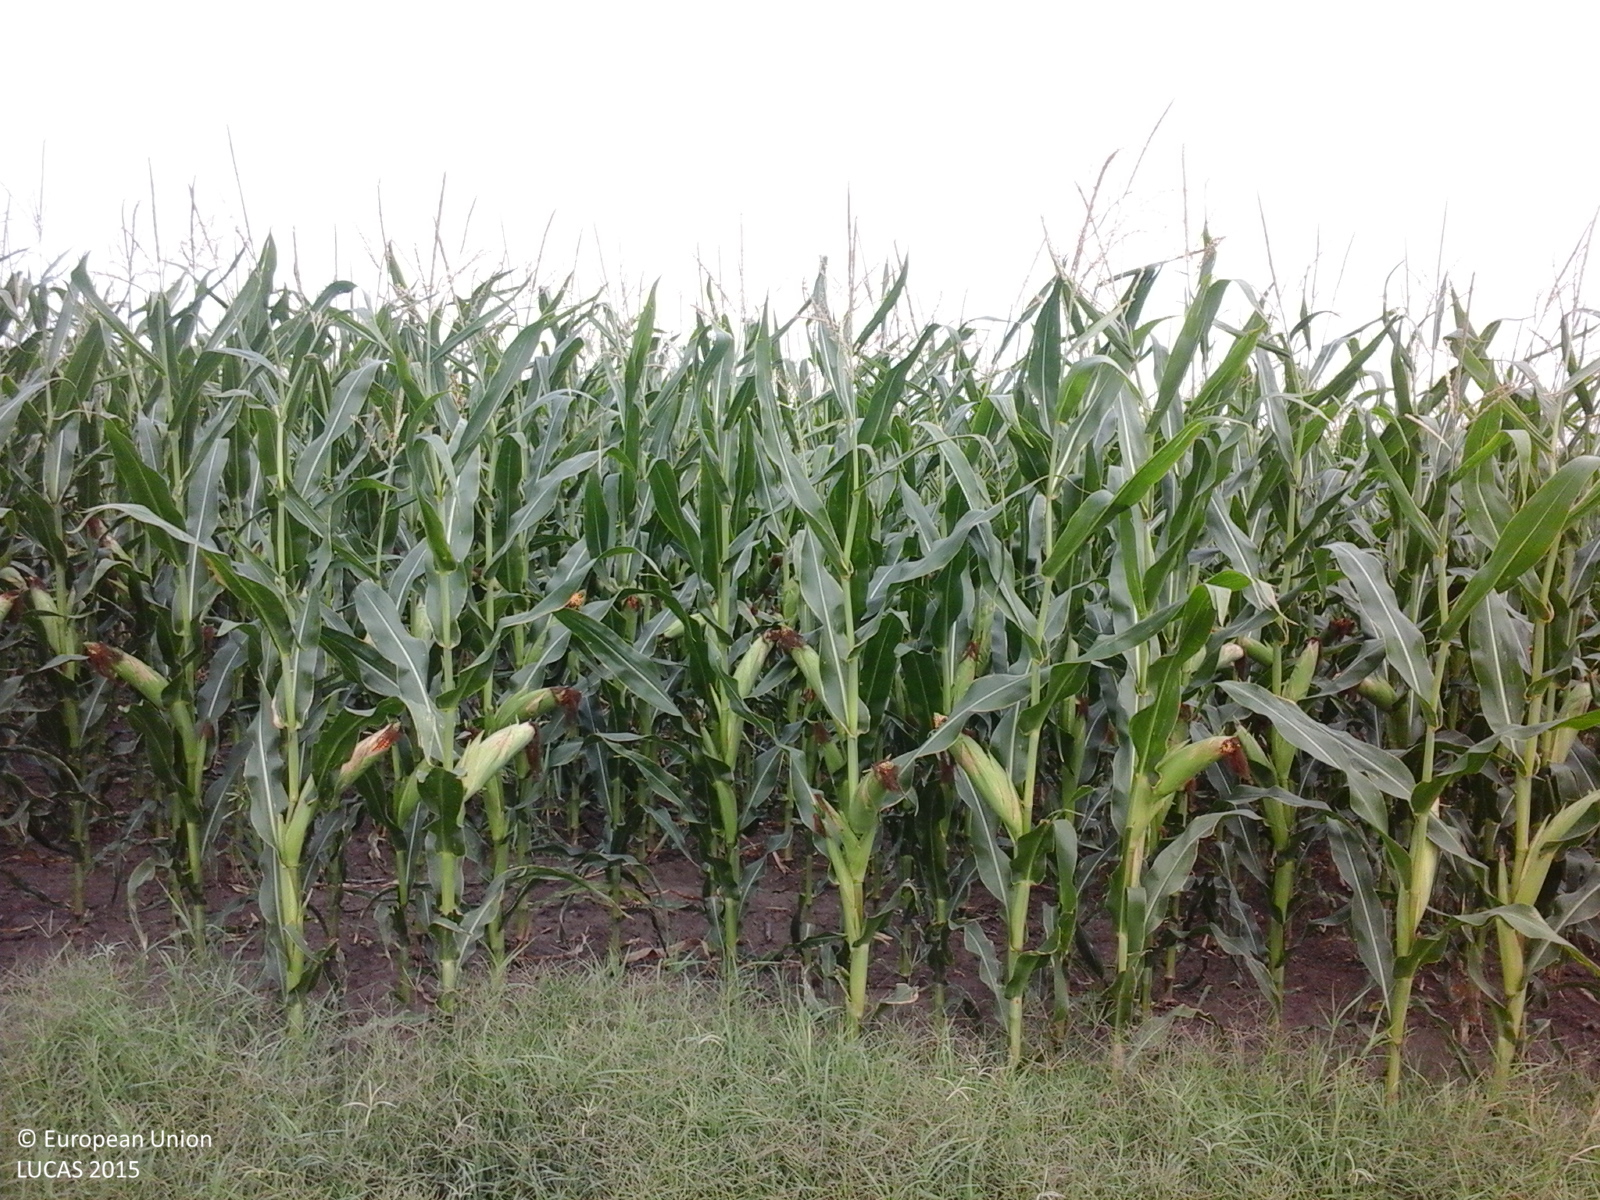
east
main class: Cropland
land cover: Maize
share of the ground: > 75 %
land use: Agriculture (excluding fallow land and kitchen gardens)
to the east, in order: Maize
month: August
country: RO
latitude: 45.0588
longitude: 27.6133
